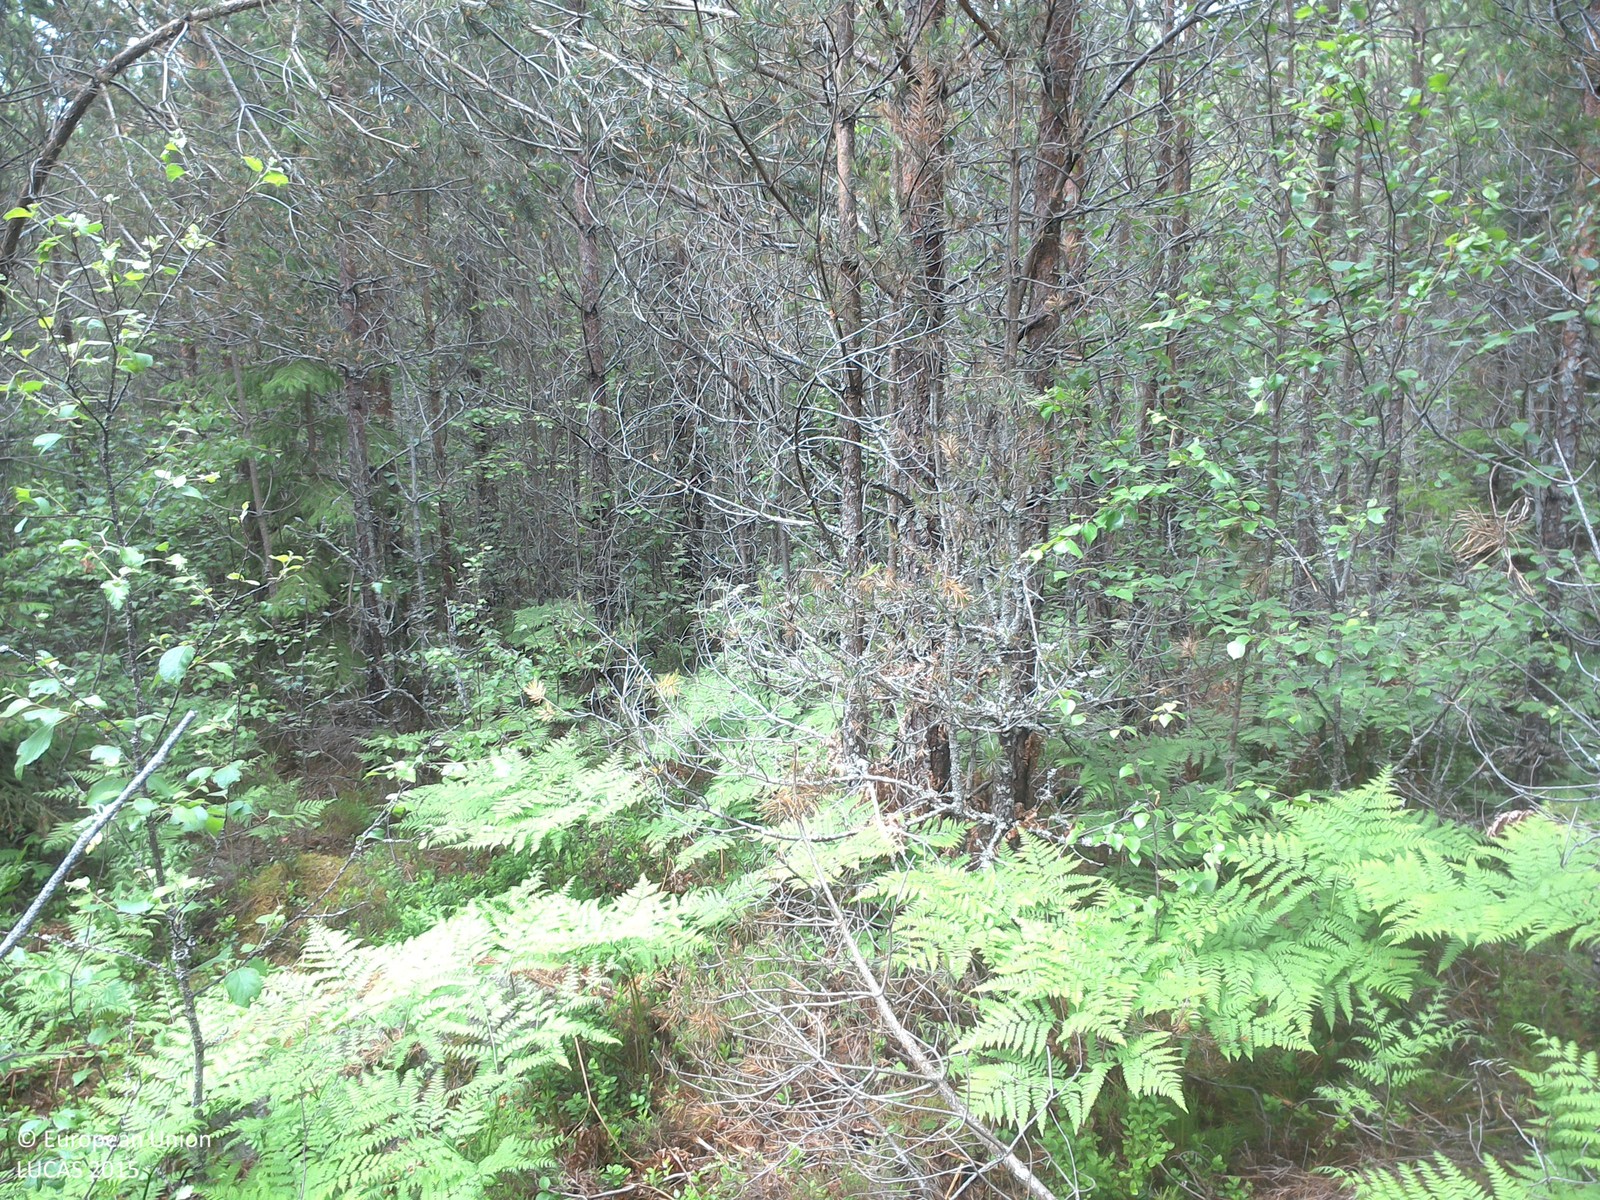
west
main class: Woodland
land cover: Pine dominated coniferous woodland
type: boreal forest
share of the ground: 50 - 75 %
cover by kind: coniferous forest trees 70 %, lichens and mosses 25 %, herbaceous plants 5 %
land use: Forestry
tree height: > 5 m
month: June
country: SE
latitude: 58.1217
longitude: 15.5807
